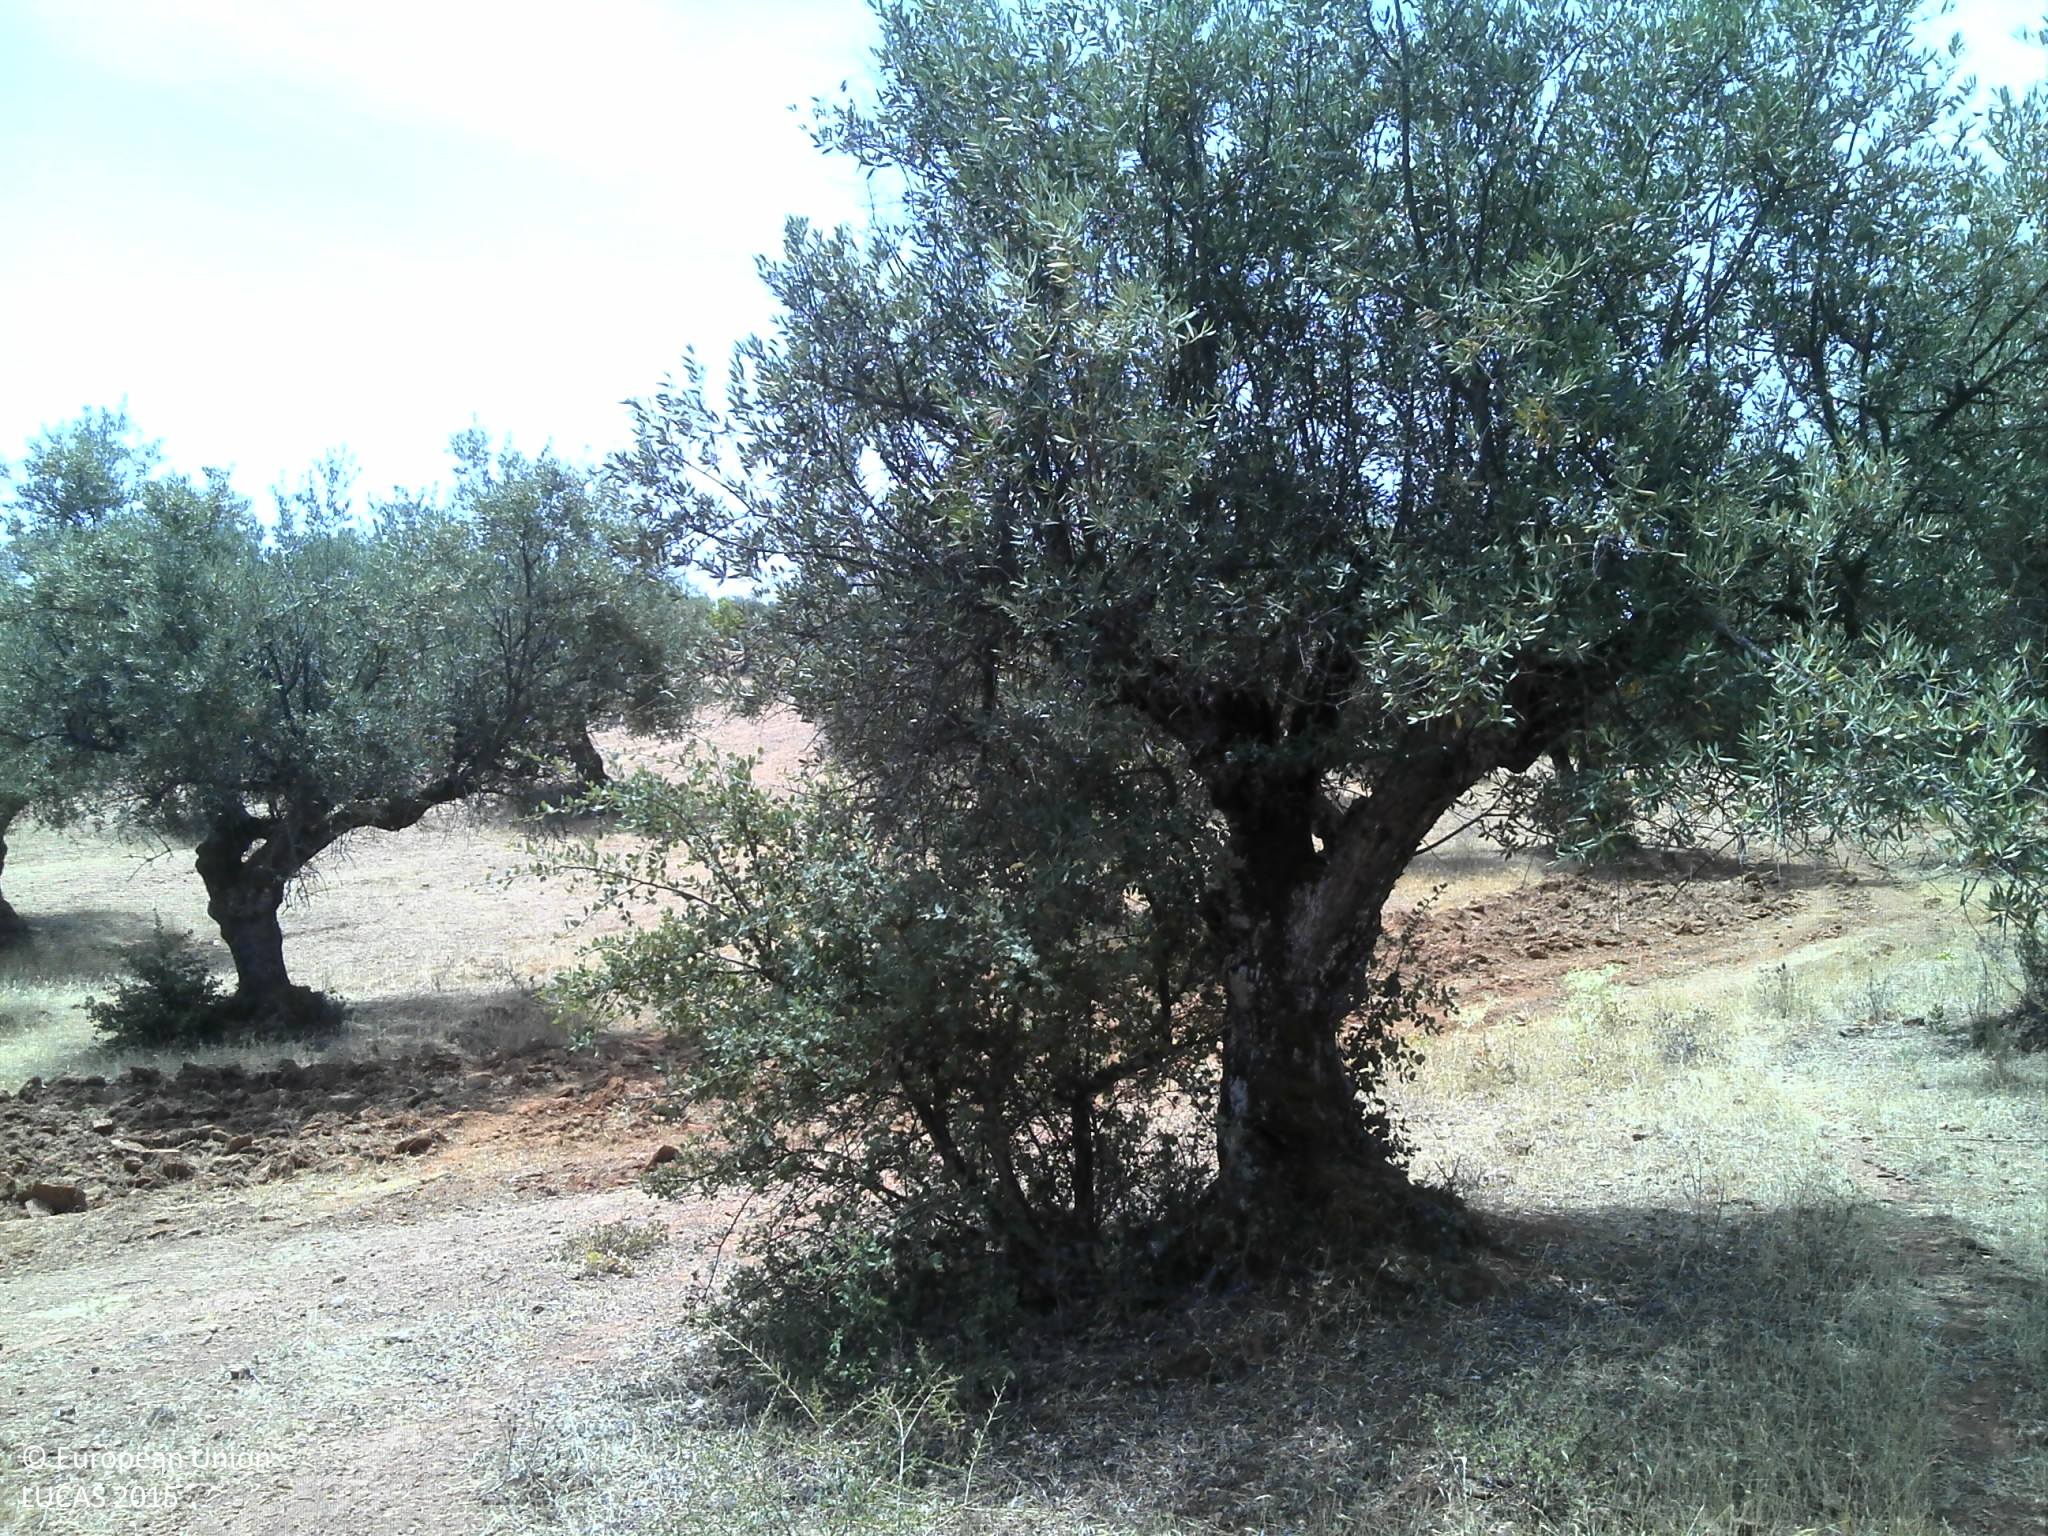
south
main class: Cropland
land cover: Olive groves
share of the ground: 25 - 50 %
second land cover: Grassland without tree/shrub cover
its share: 25 - 50 %
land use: Agriculture (excluding fallow land and kitchen gardens)
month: July
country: PT
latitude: 38.2231
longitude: -7.6754
